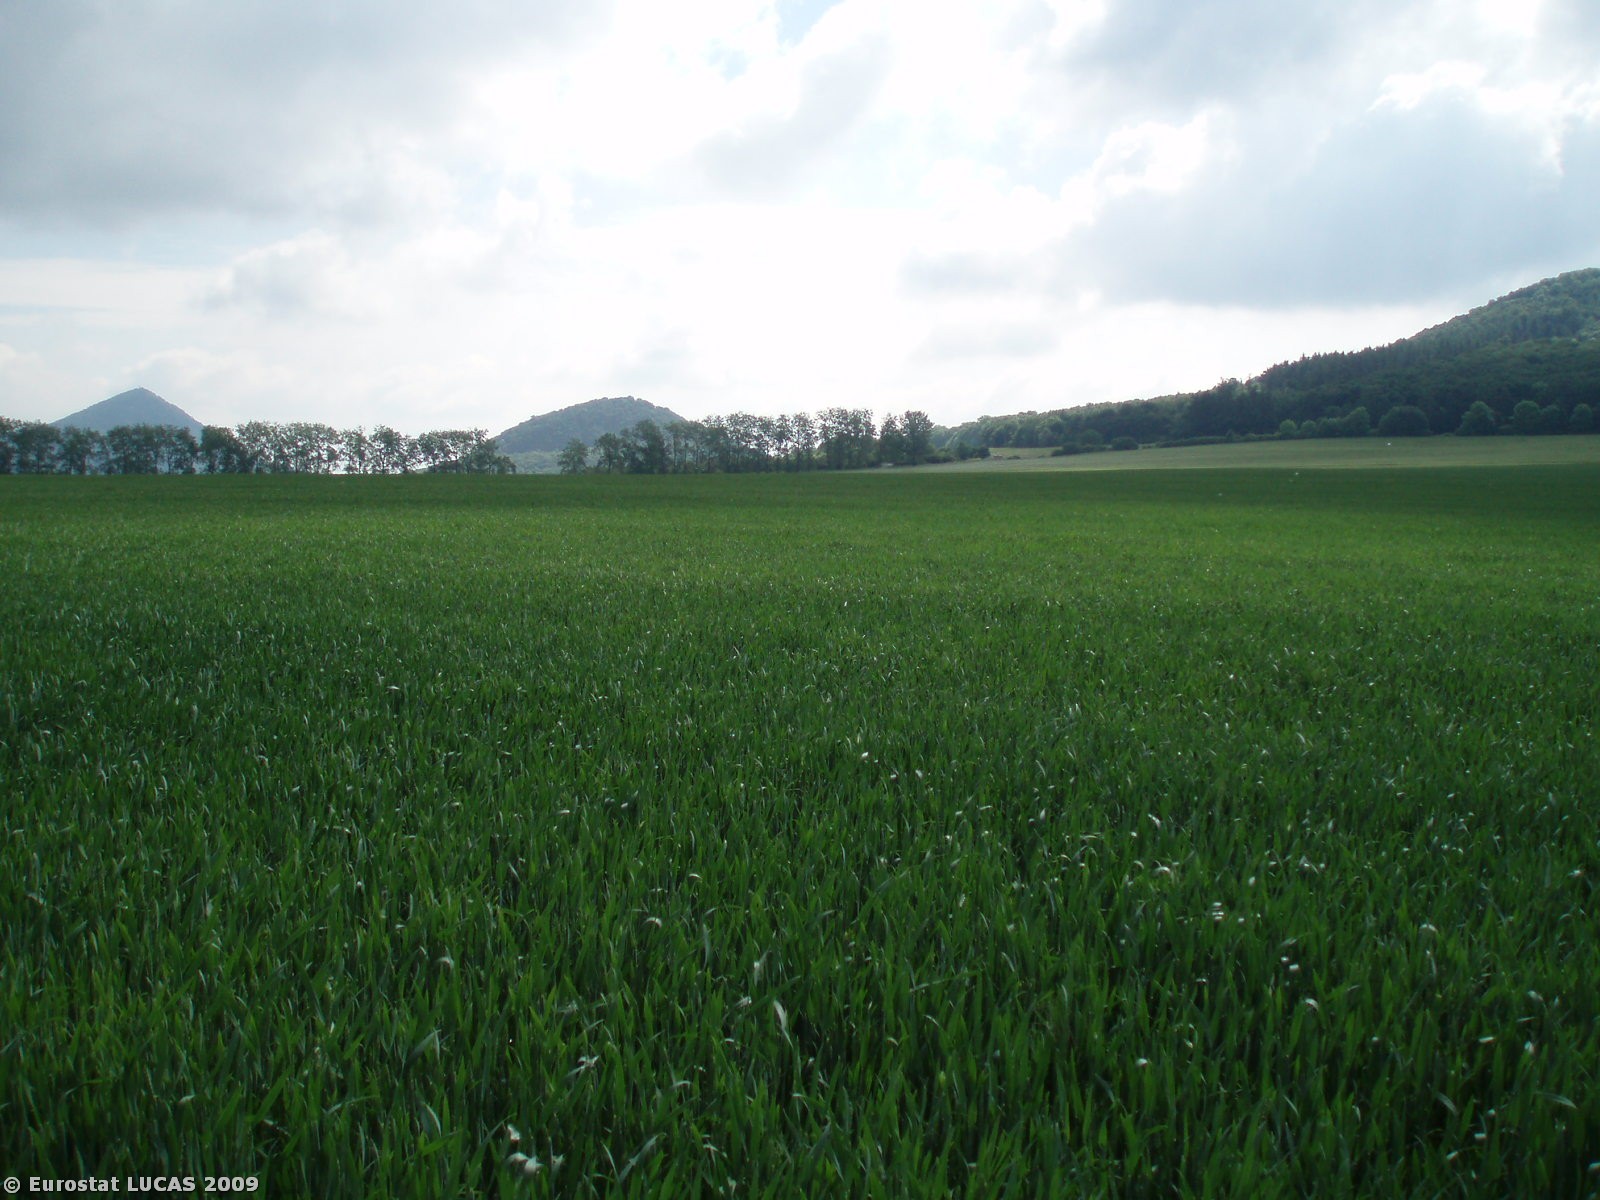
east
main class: Cropland
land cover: Common wheat
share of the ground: > 75 %
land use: Agriculture (excluding fallow land and kitchen gardens)
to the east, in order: Common wheat
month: June
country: CZ
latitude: 50.5115
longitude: 13.9635
